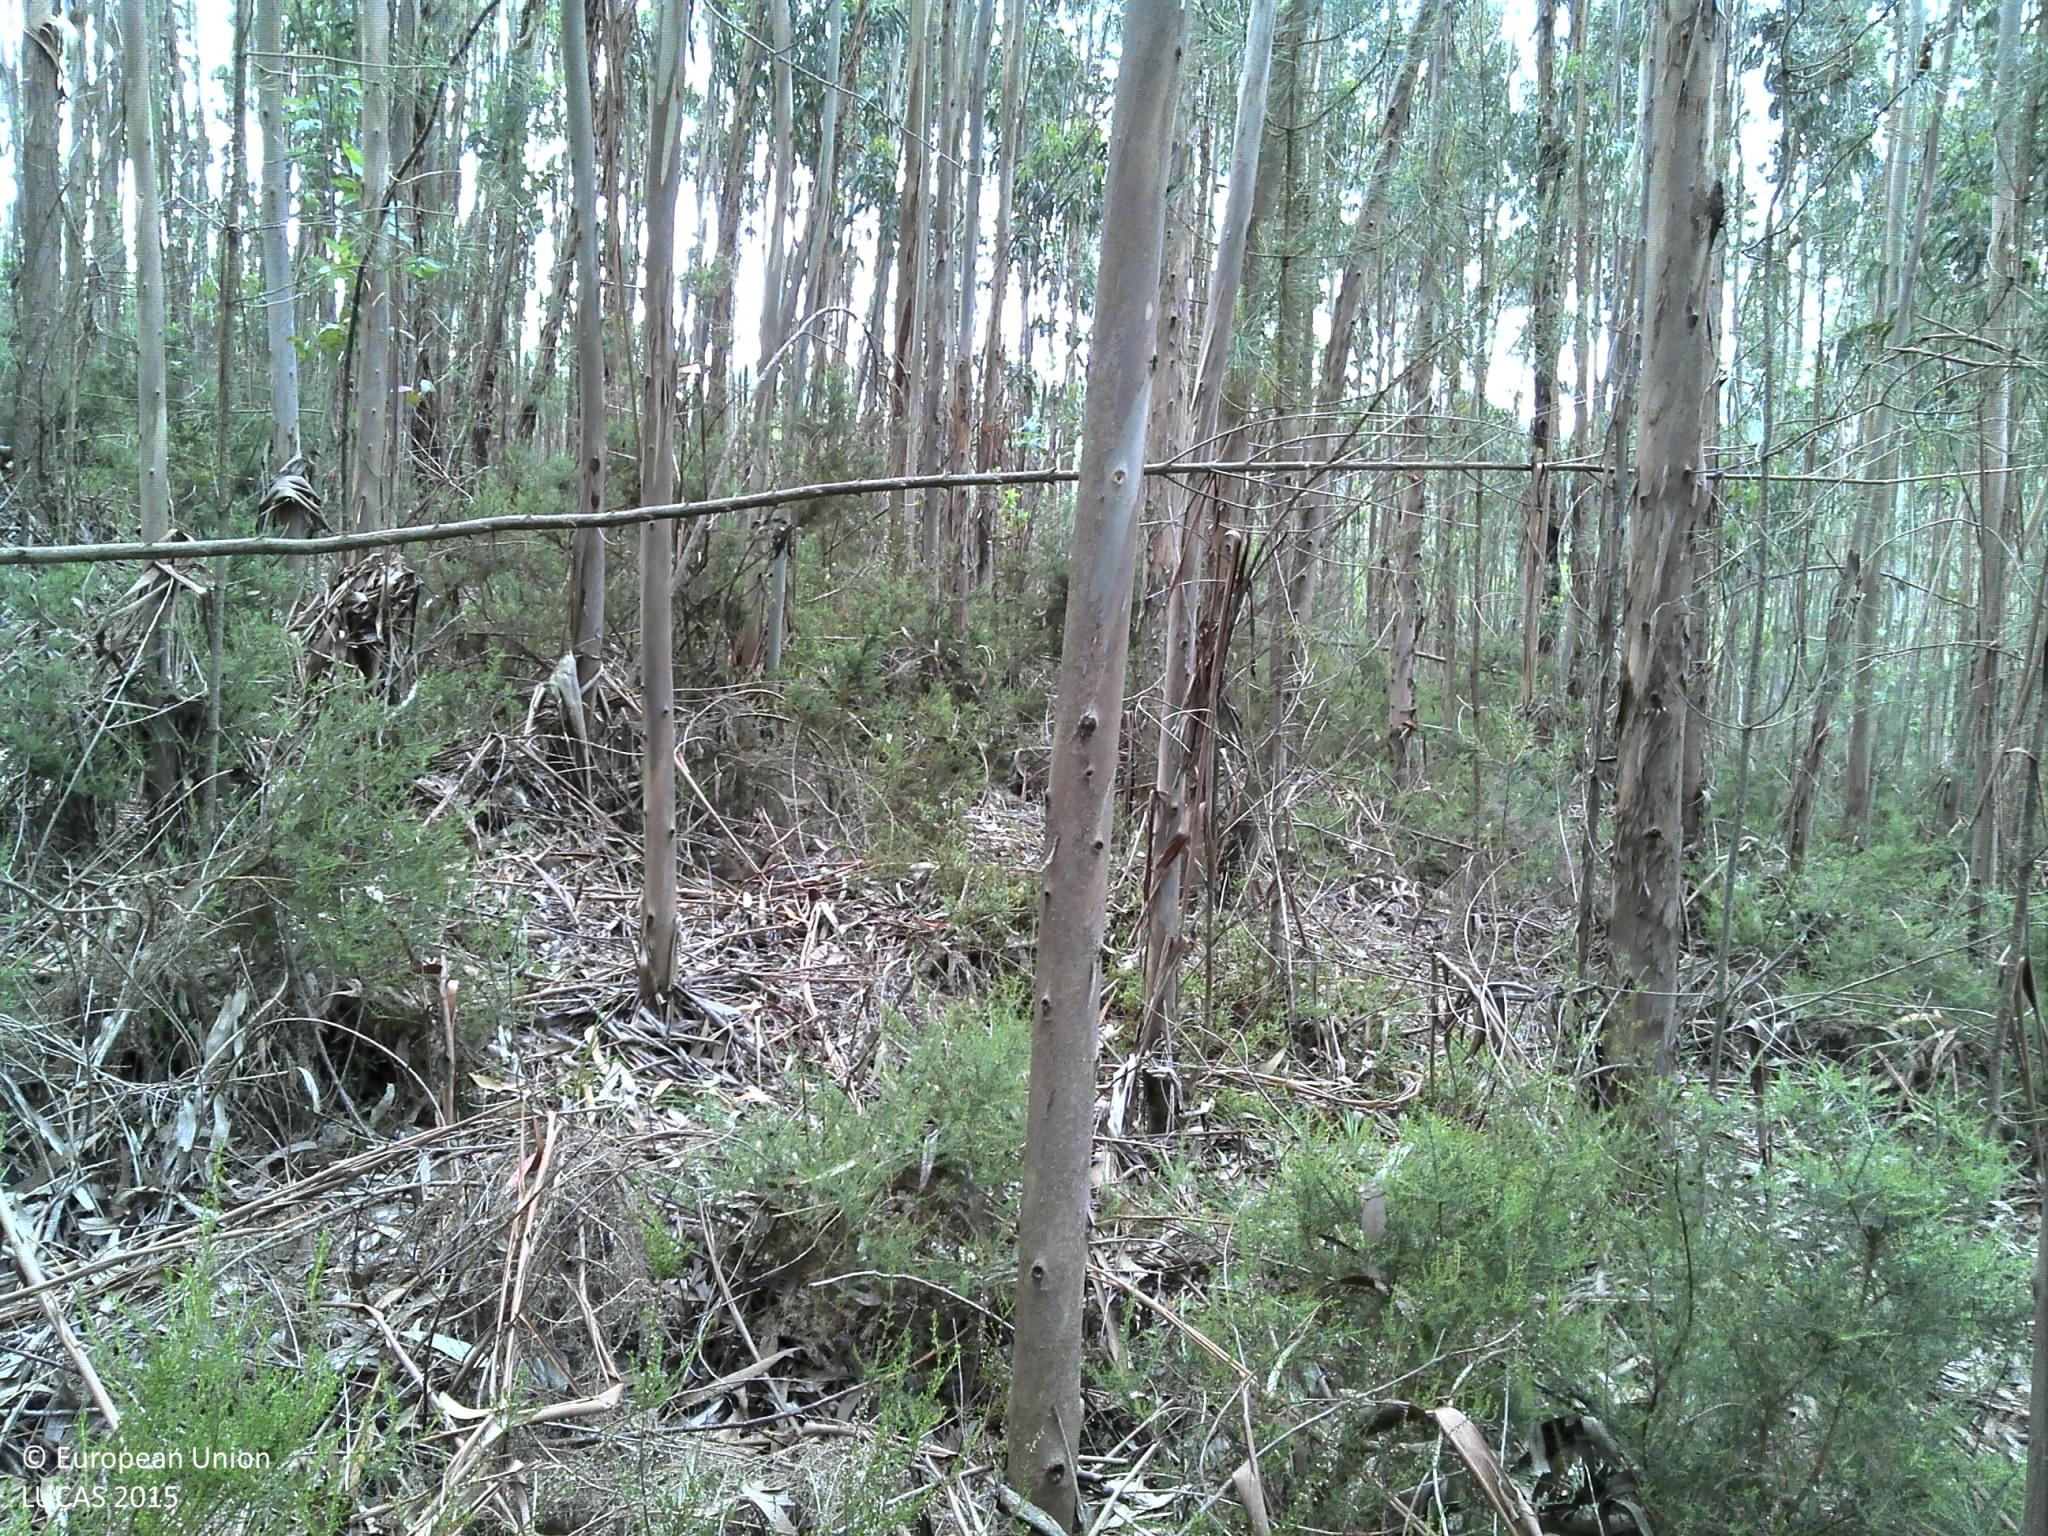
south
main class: Woodland
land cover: Broadleaved woodland
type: exotic forest
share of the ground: > 75 %
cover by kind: broadleaved forest trees 85 %, shrubs 15 %
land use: Forestry
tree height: > 5 m
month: May
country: PT
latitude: 41.0643
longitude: -8.3873
